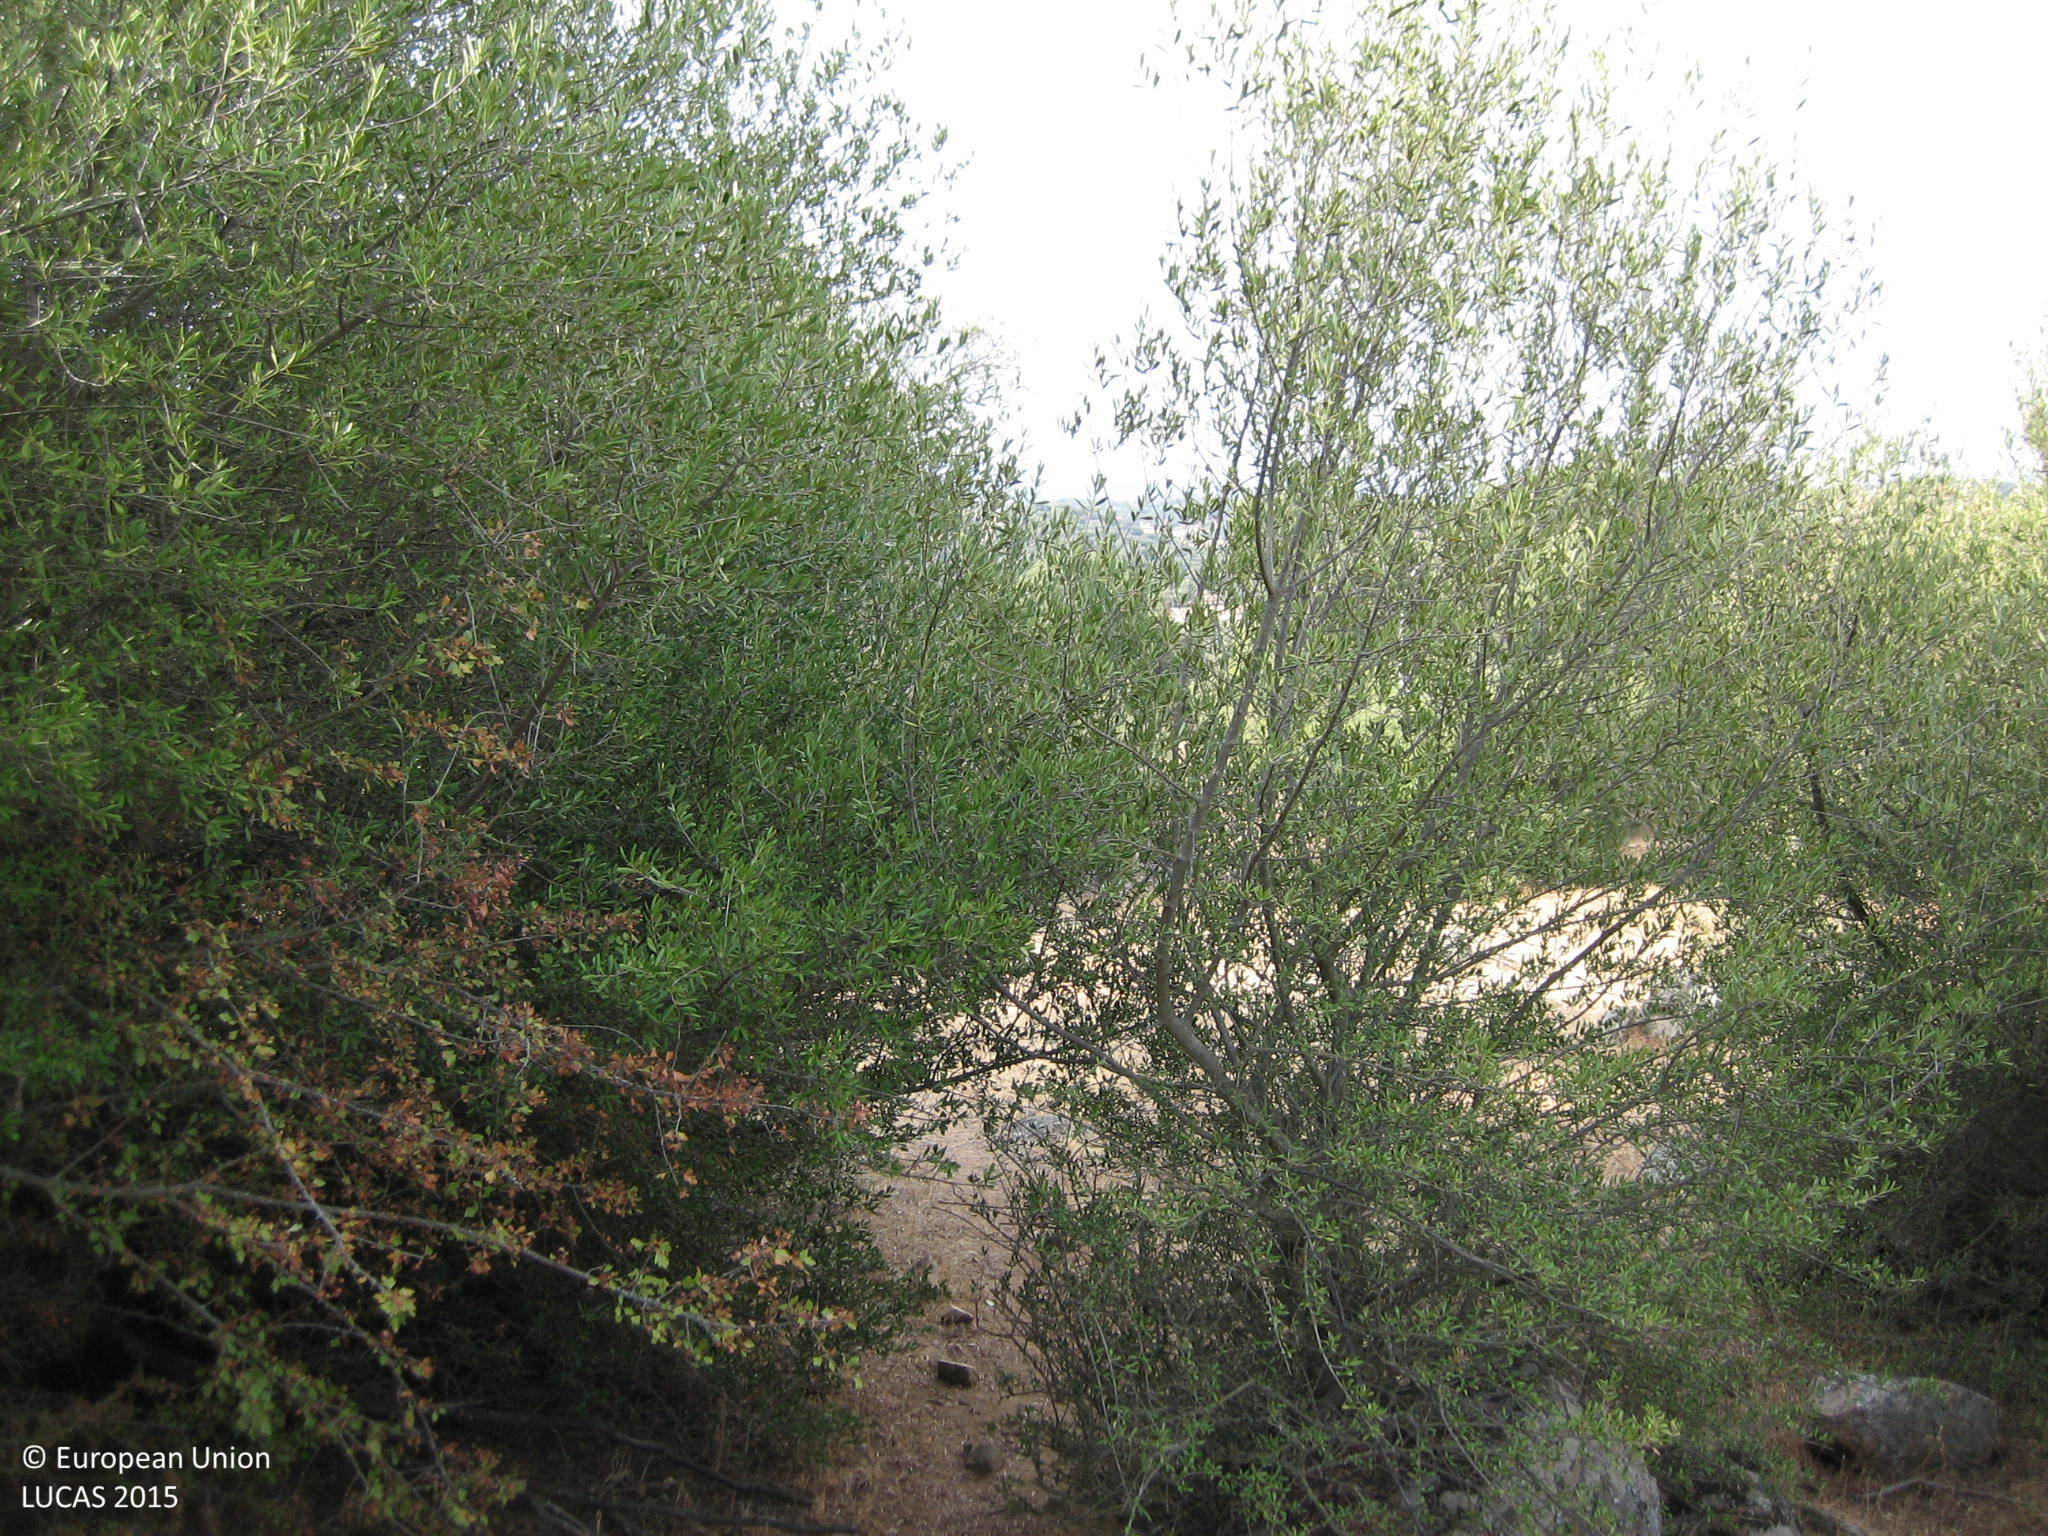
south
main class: Woodland
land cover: Broadleaved woodland
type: broadleaved evergreen forest
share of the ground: 50 - 75 %
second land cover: Grassland without tree/shrub cover
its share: 25 - 50 %
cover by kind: broadleaved forest trees 50 %, herbaceous plants 25 %, consolidated bare surface 20 %, shrubs 5 %
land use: Forestry
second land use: Agriculture (excluding fallow land and kitchen gardens)
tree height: > 5 m
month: September
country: ES
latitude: 38.5583
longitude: -6.8503
